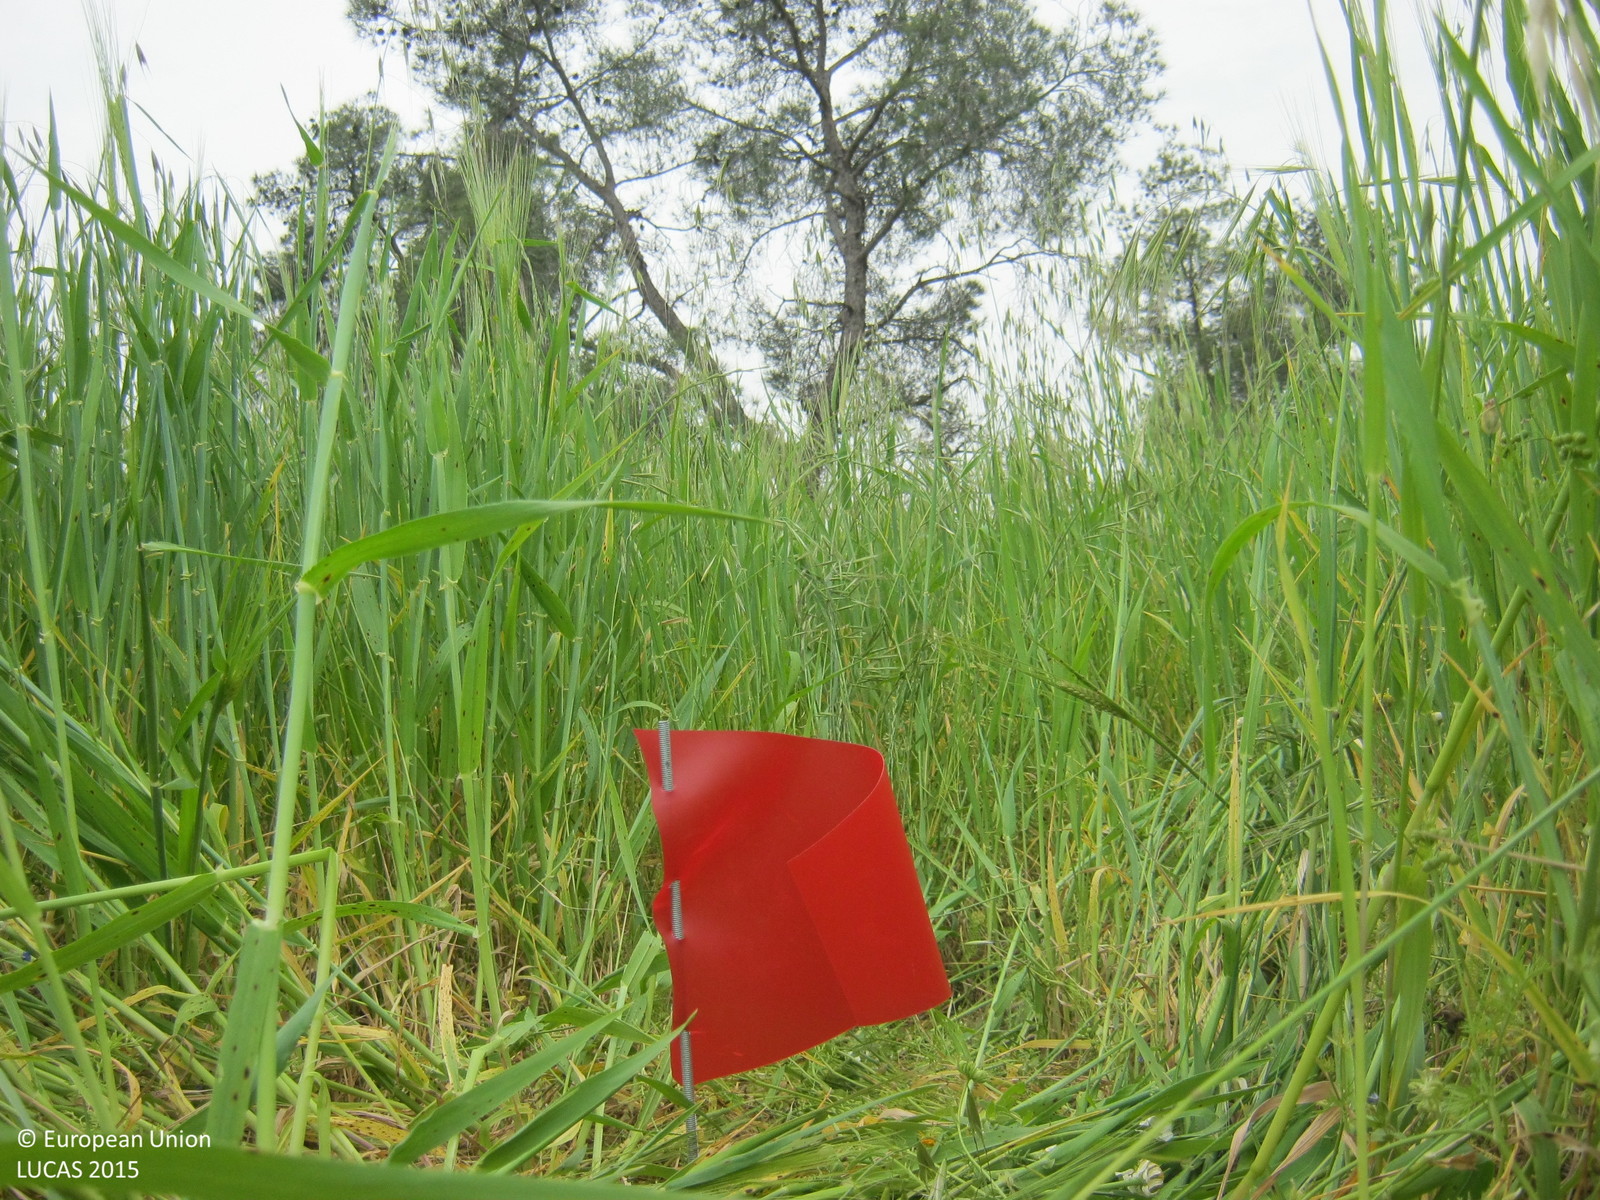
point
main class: Cropland
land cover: Common wheat
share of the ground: > 75 %
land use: Agriculture (excluding fallow land and kitchen gardens)
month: April
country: CY
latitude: 34.9263
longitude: 33.3604
